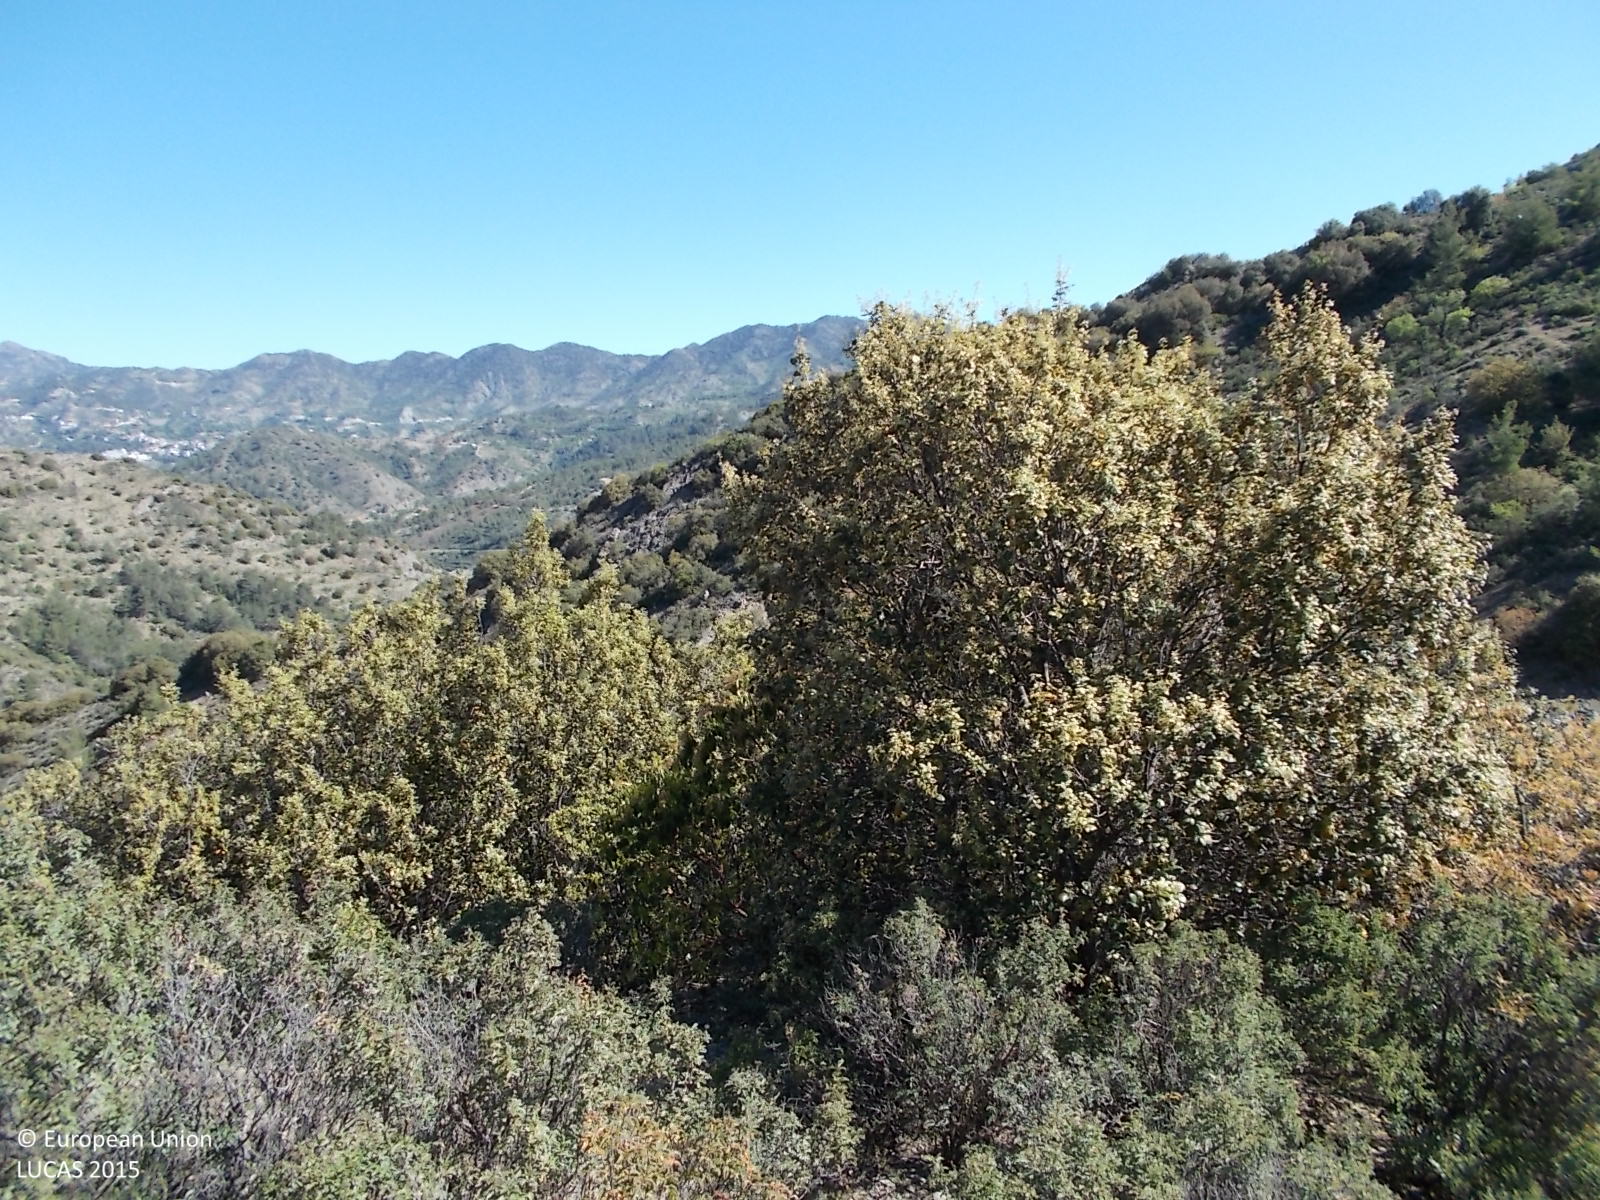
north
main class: Shrubland
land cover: Shrubland with sparse tree cover
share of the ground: > 75 %
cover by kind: shrubs 95 %, broadleaved forest trees 5 %
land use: Semi-natural and natural areas not in use
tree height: < 5 m
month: May
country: CY
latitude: 34.8810
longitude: 33.0265
